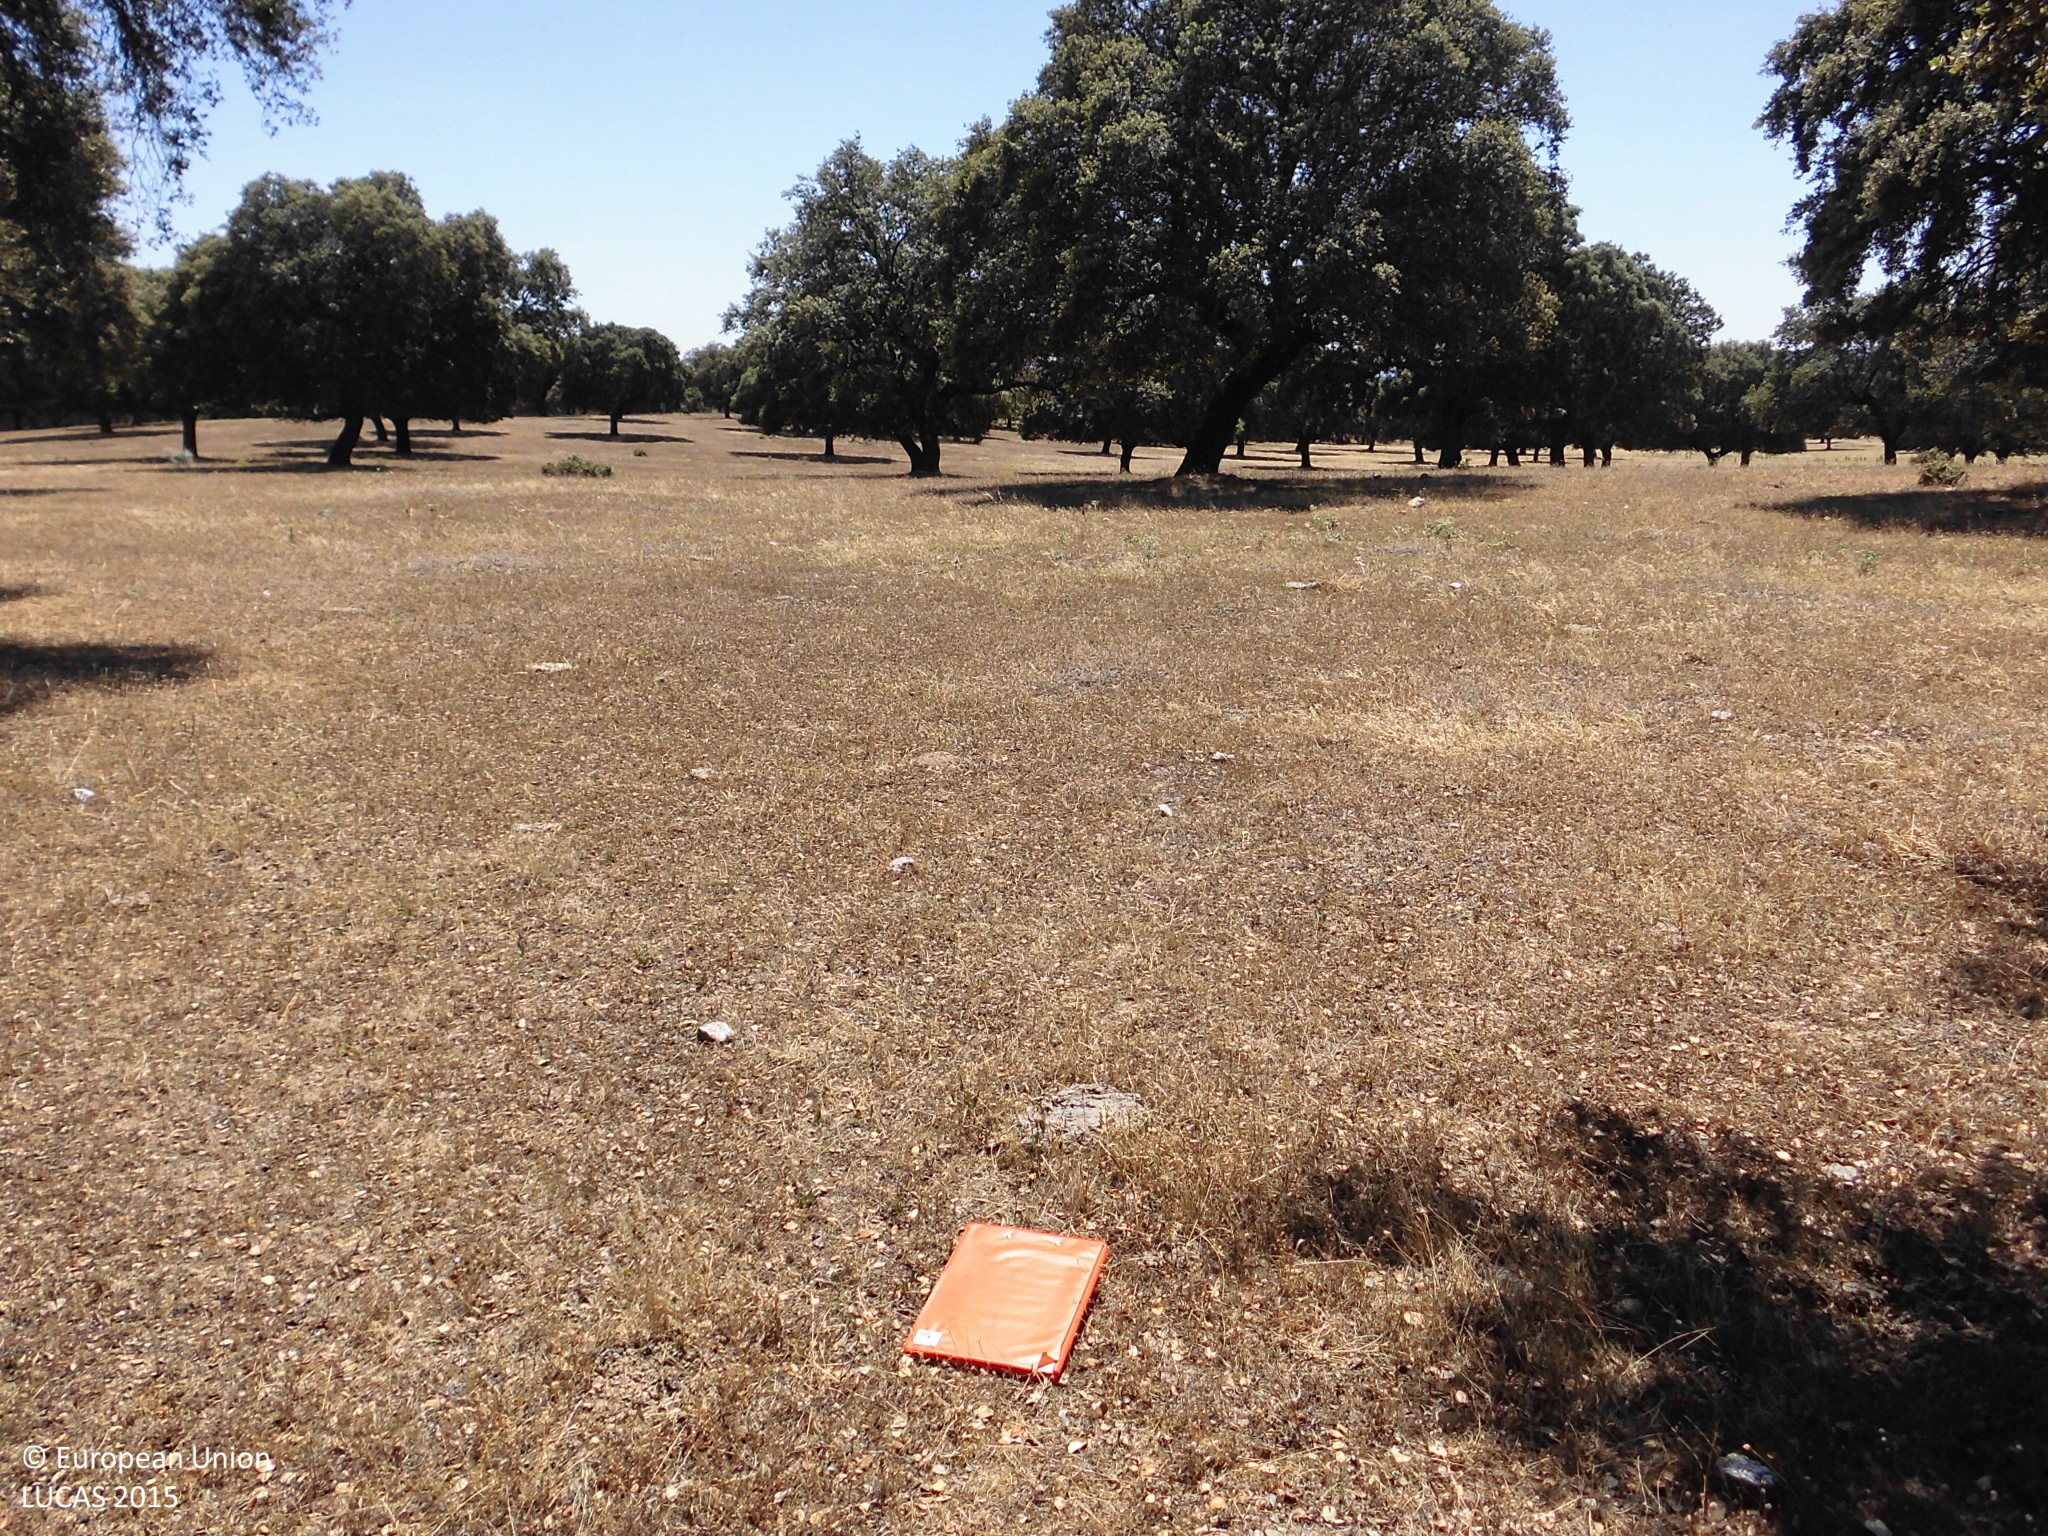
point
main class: Woodland
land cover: Broadleaved woodland
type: broadleaved evergreen forest
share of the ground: 10 - 25 %
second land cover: Grassland without tree/shrub cover
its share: > 75 %
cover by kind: herbaceous plants 80 %, broadleaved forest trees 20 %
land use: Forestry
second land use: Agriculture (excluding fallow land and kitchen gardens)
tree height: > 5 m
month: June
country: ES
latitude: 39.9729
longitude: -6.1238
